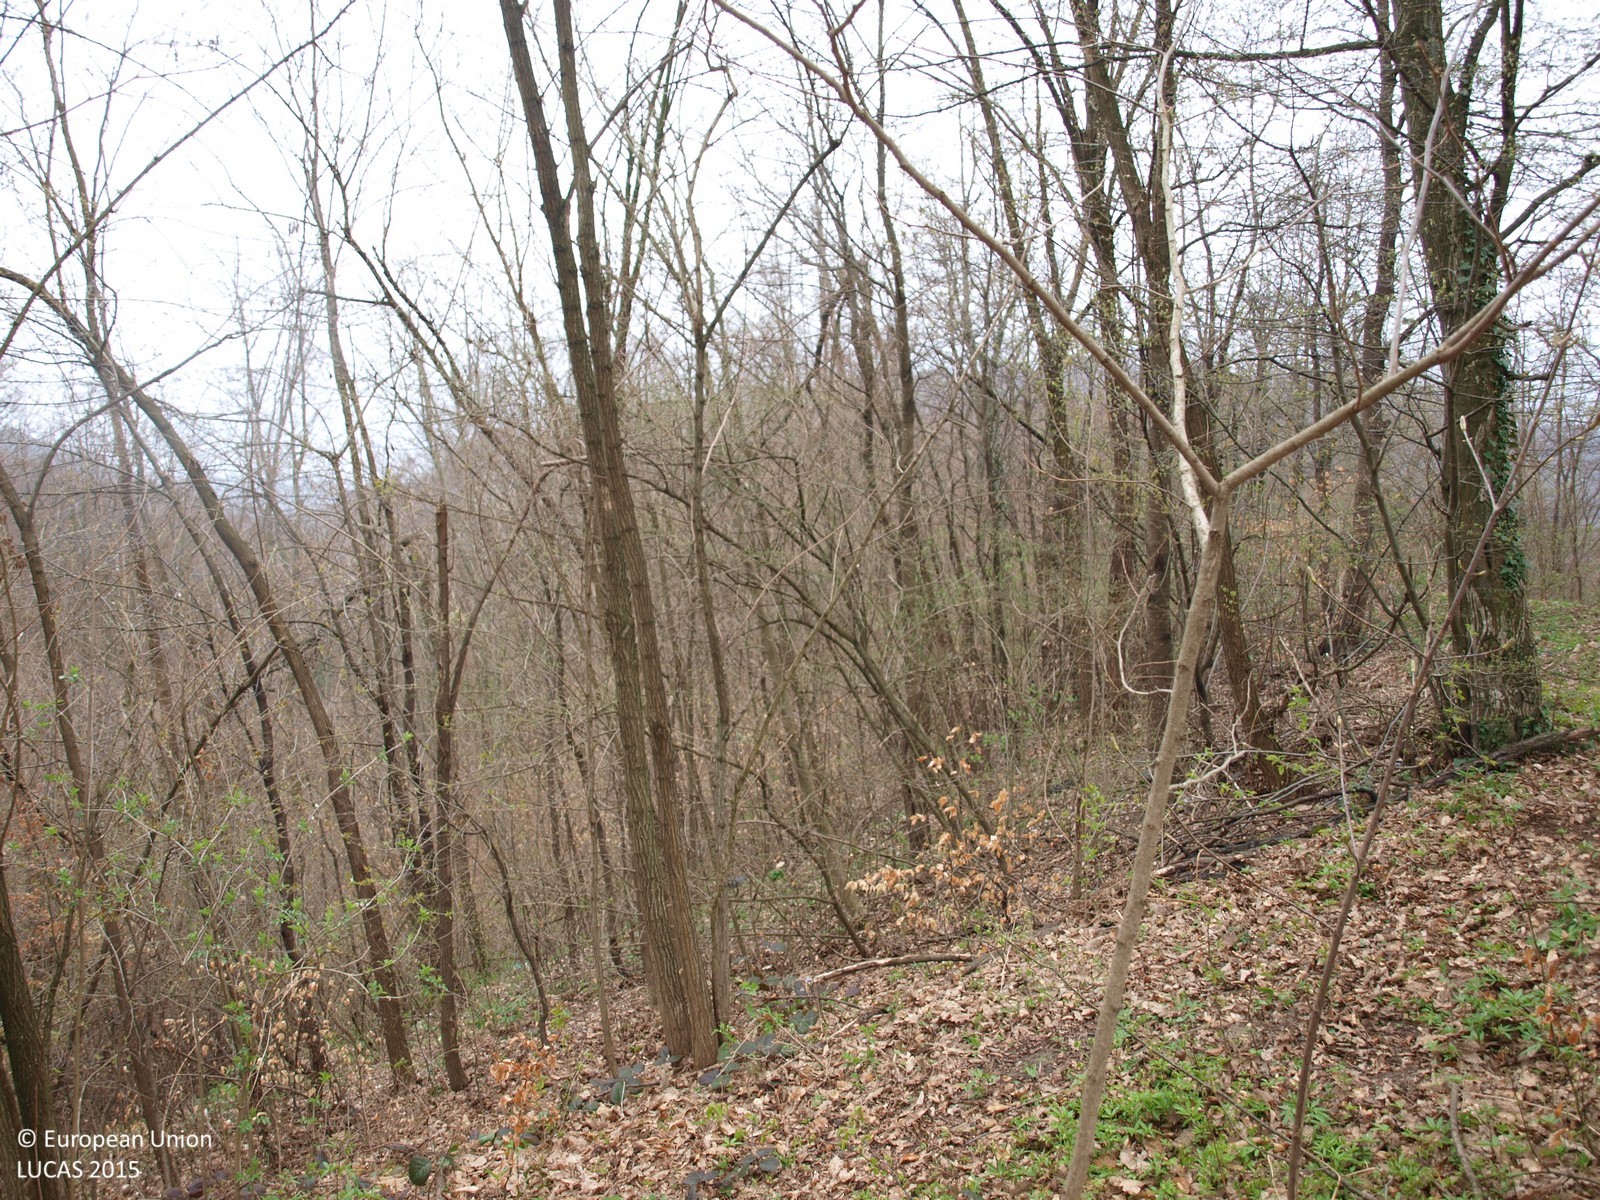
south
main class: Woodland
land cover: Broadleaved woodland
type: mesophytic deciduous forest
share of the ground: > 75 %
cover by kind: broadleaved forest trees 90 %
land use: Forestry
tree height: > 5 m
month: April
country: HR
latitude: 46.1806
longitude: 15.7113
